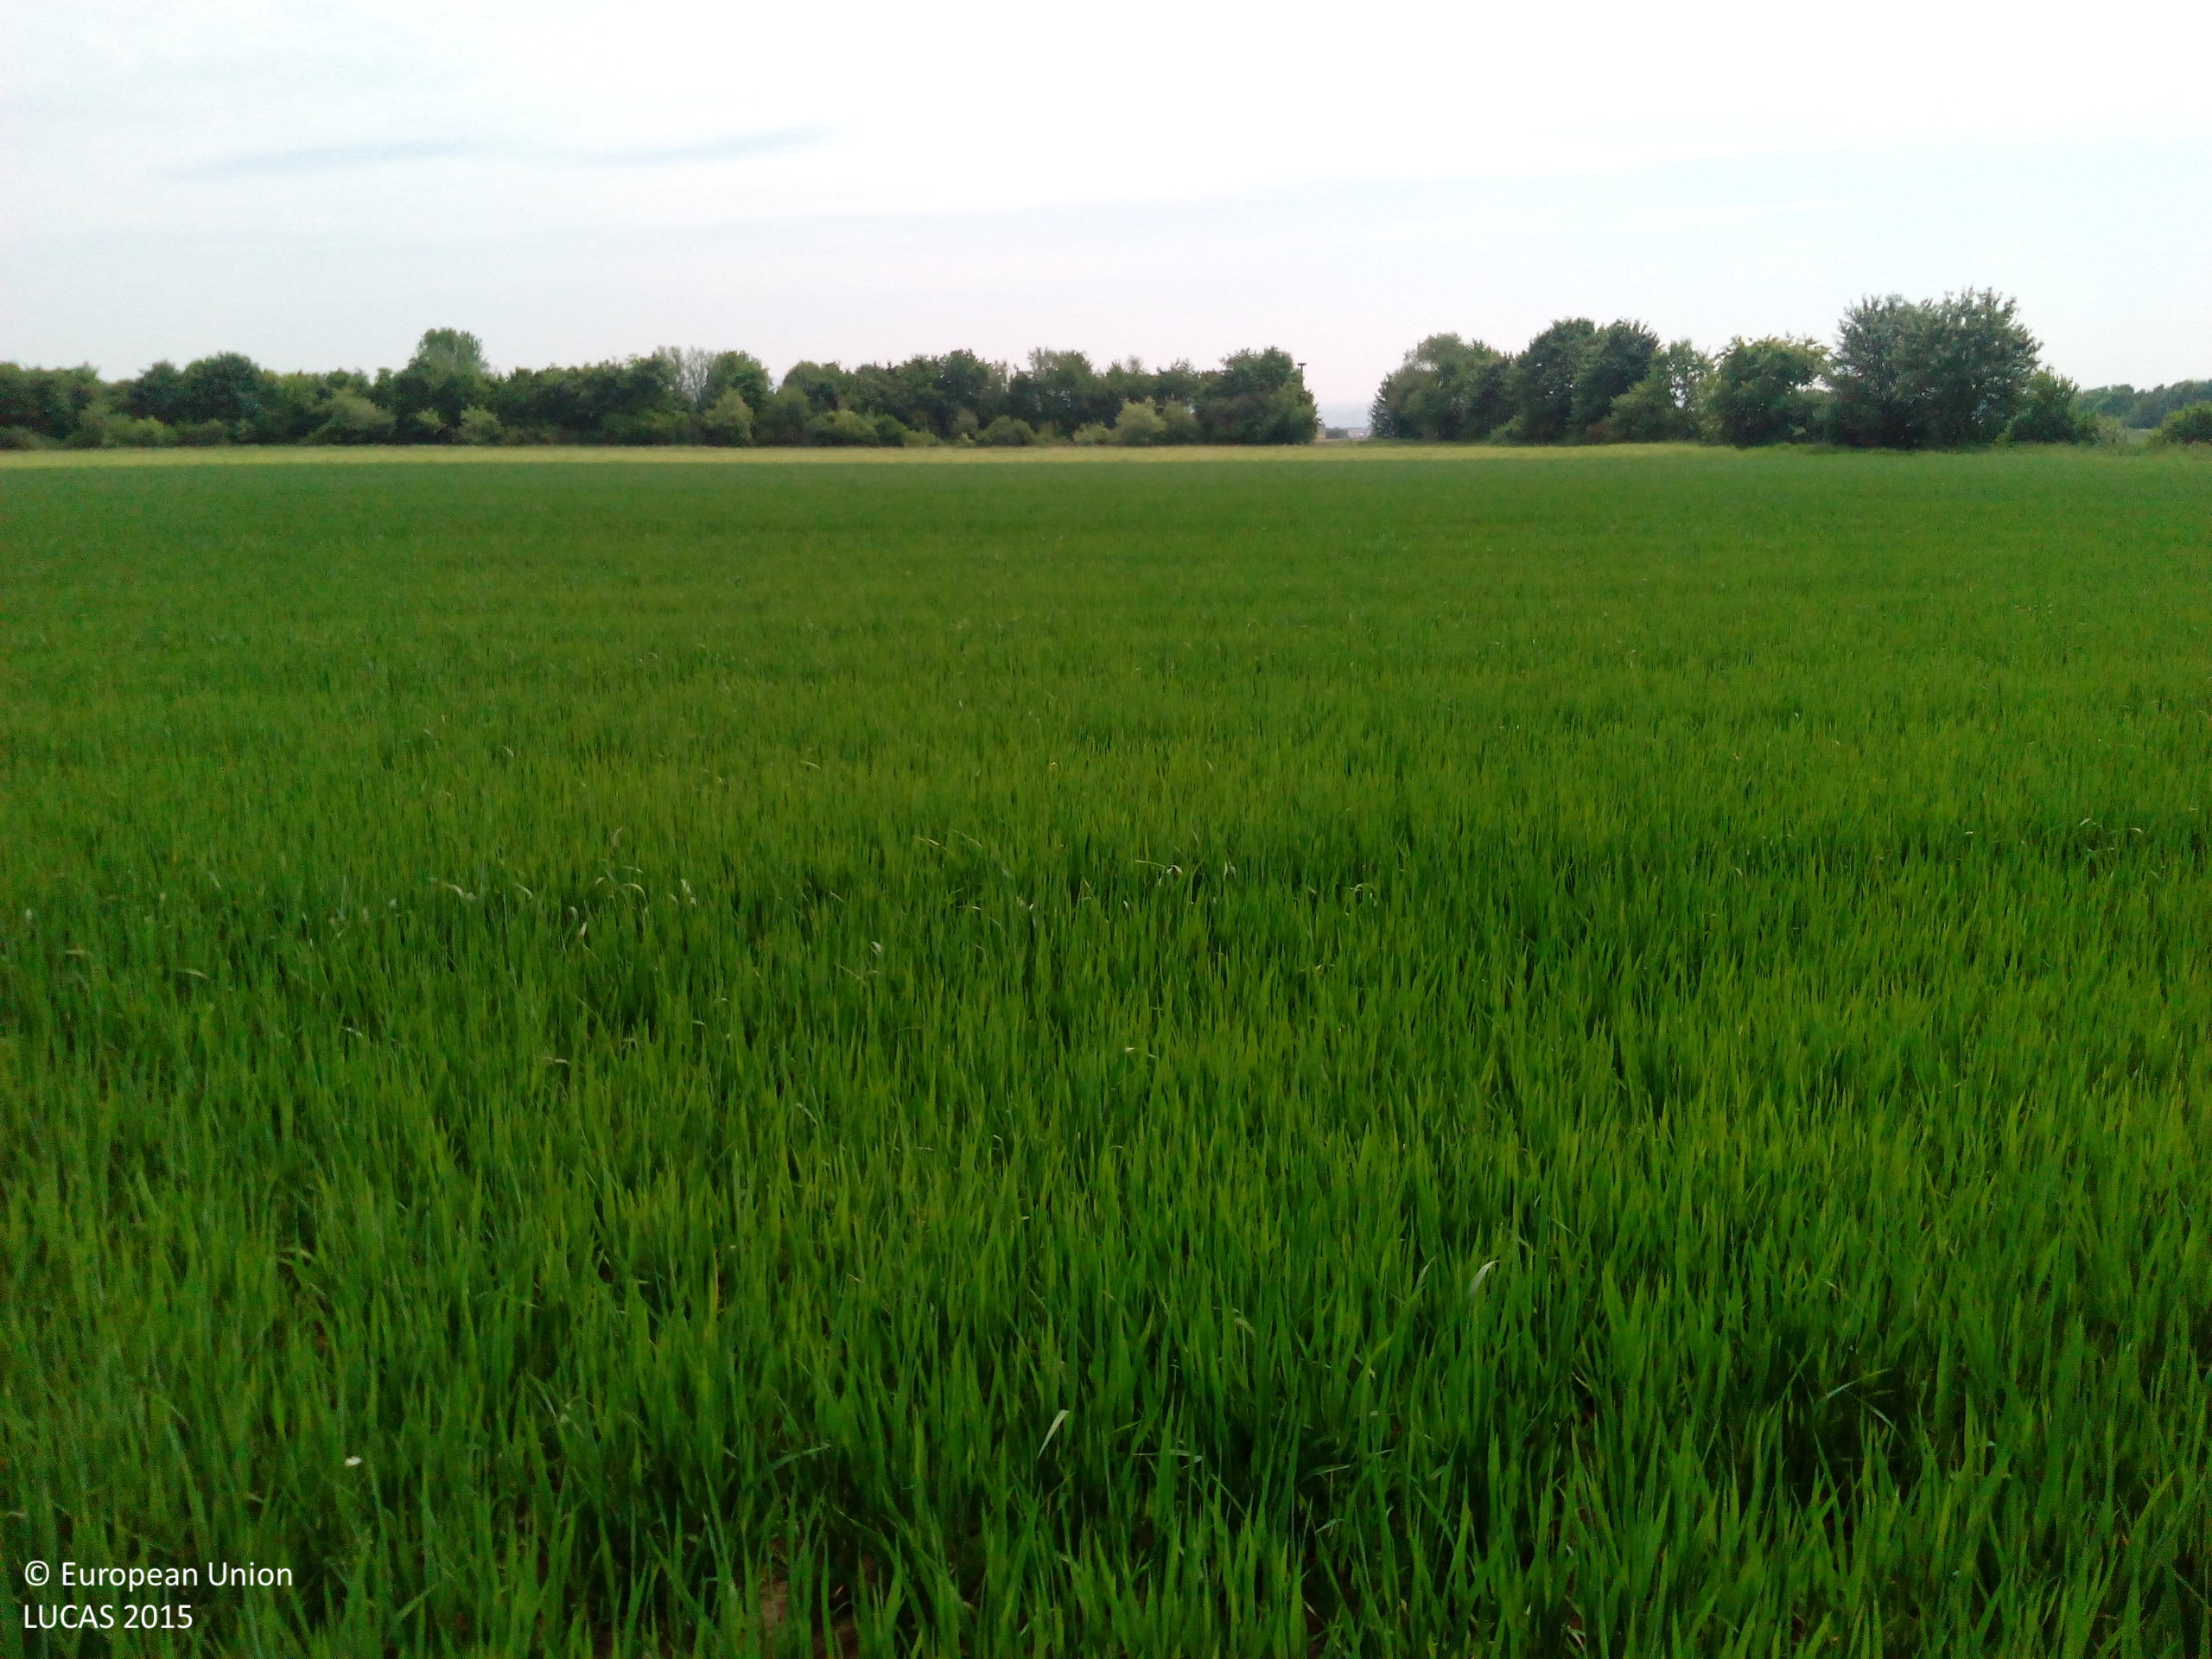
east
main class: Cropland
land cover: Oats
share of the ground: > 75 %
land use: Agriculture (excluding fallow land and kitchen gardens)
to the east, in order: Oats; Barley; Grassland without tree/shrub cover; Broadleaved woodland; Grassland without tree/shrub cover; Other bare soil; Barley
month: May
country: DE
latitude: 49.6710
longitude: 8.5178
